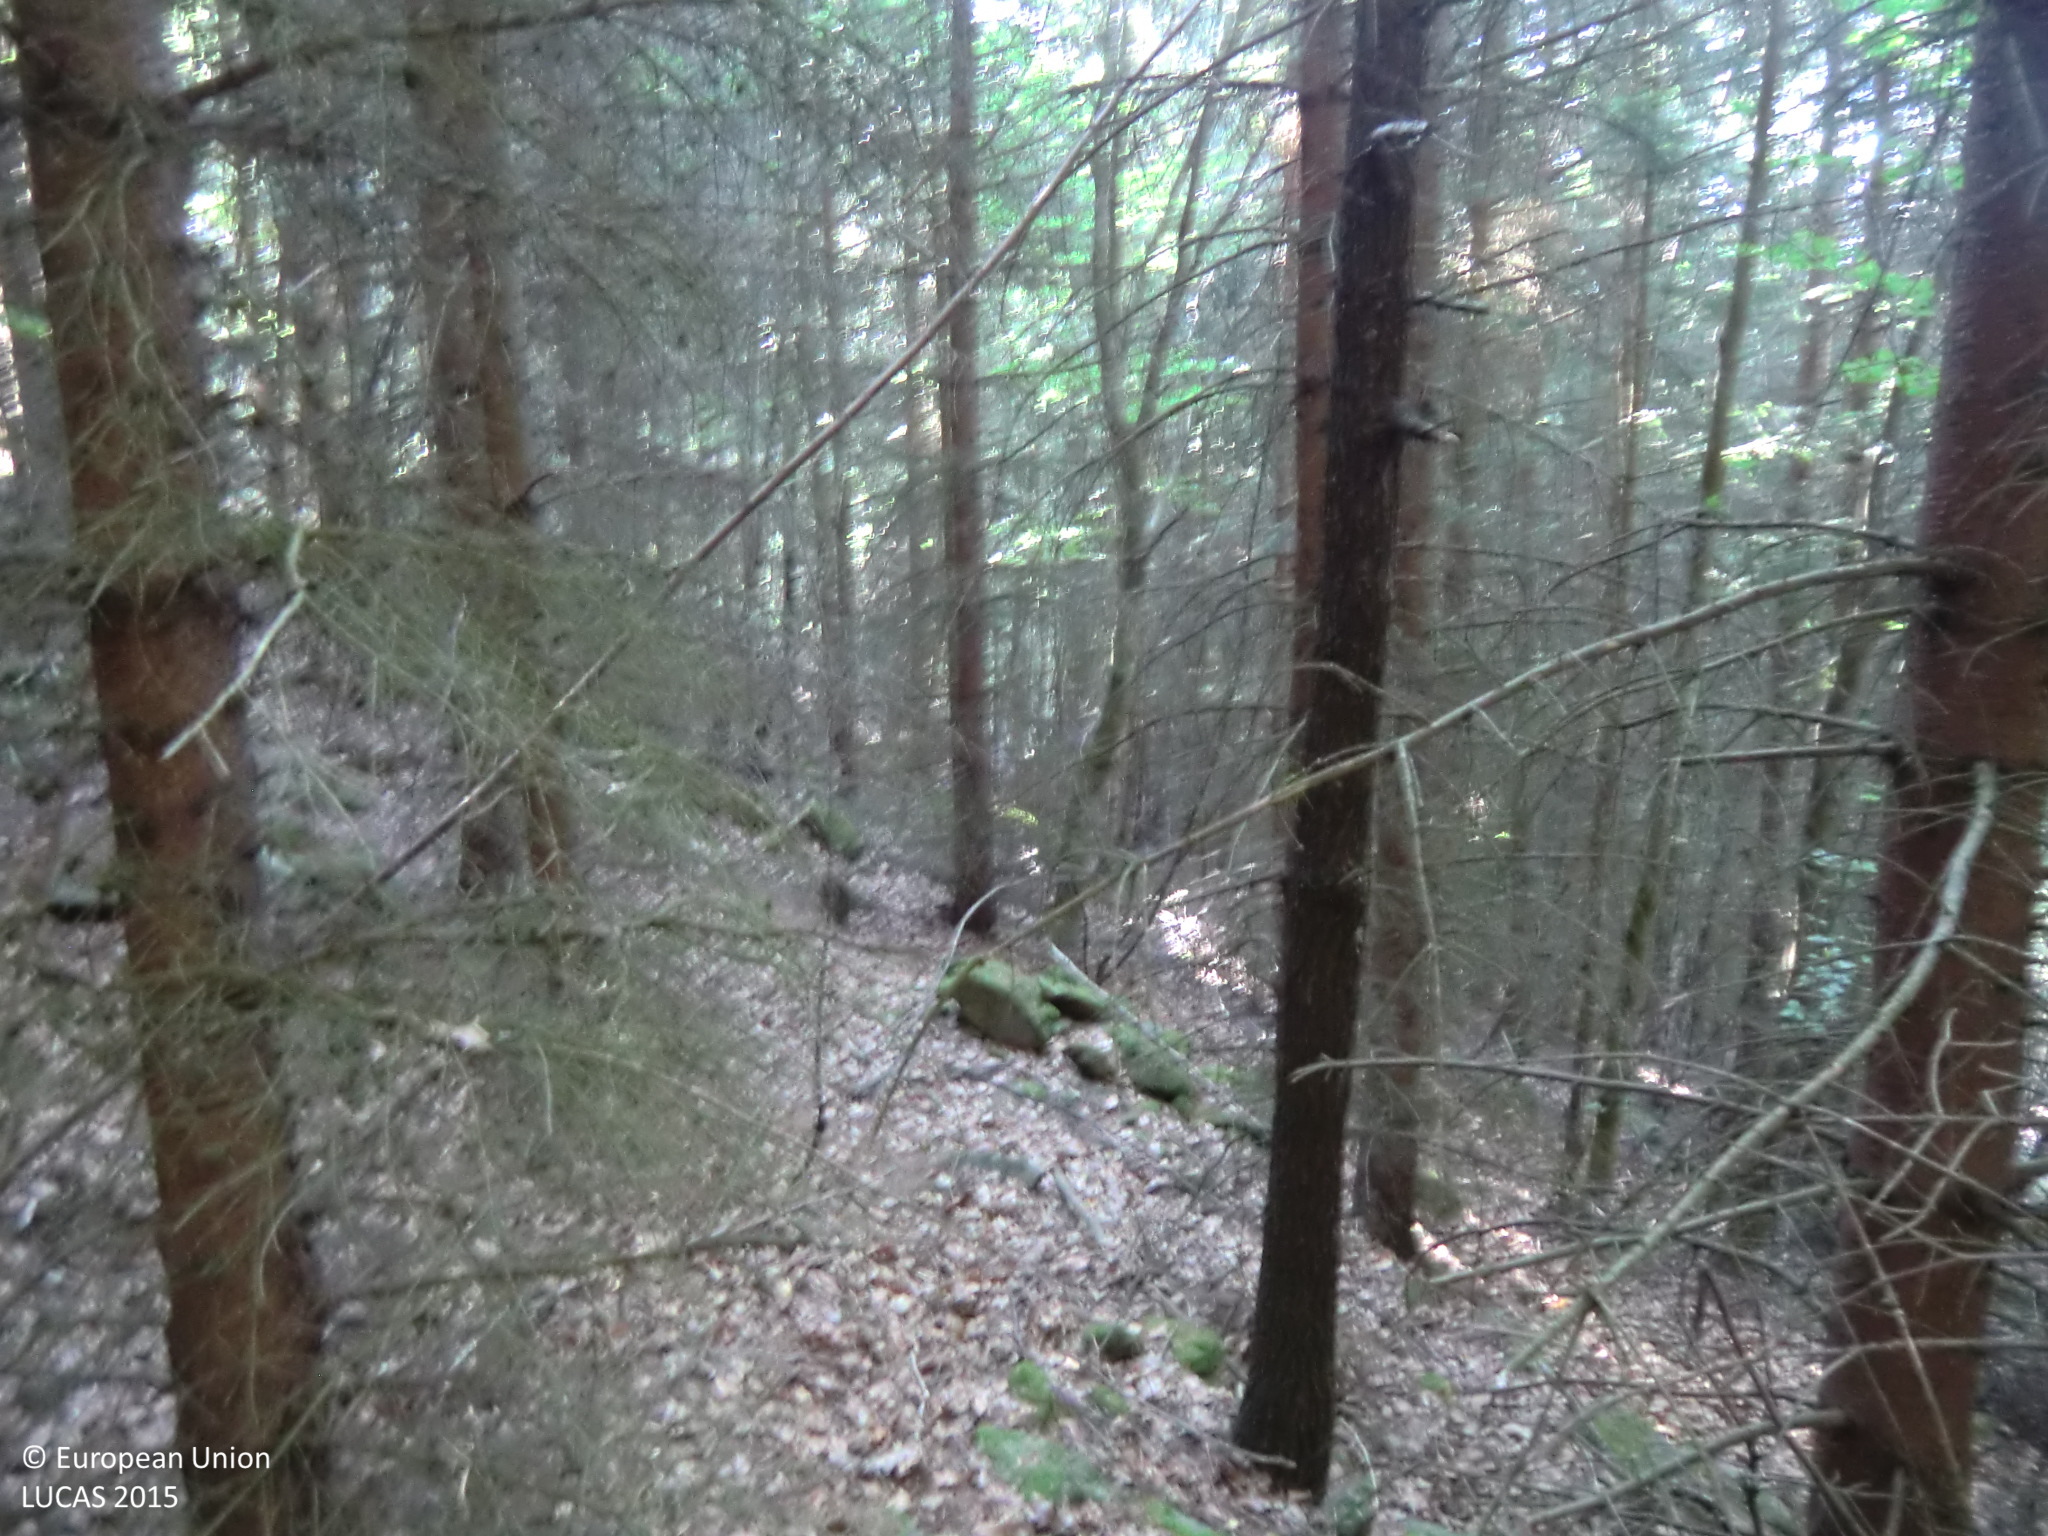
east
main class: Woodland
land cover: Spruce dominated coniferous woodland
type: alpine coniferous forest
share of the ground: > 75 %
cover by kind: coniferous forest trees 90 %, broadleaved forest trees 5 %, consolidated bare surface 5 %
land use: Forestry
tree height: > 5 m
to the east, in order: Spruce dominated coniferous woodland; Tracks; Pine dominated mixed woodland; Grassland without tree/shrub cover
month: June
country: AT
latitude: 48.4592
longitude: 14.4225
